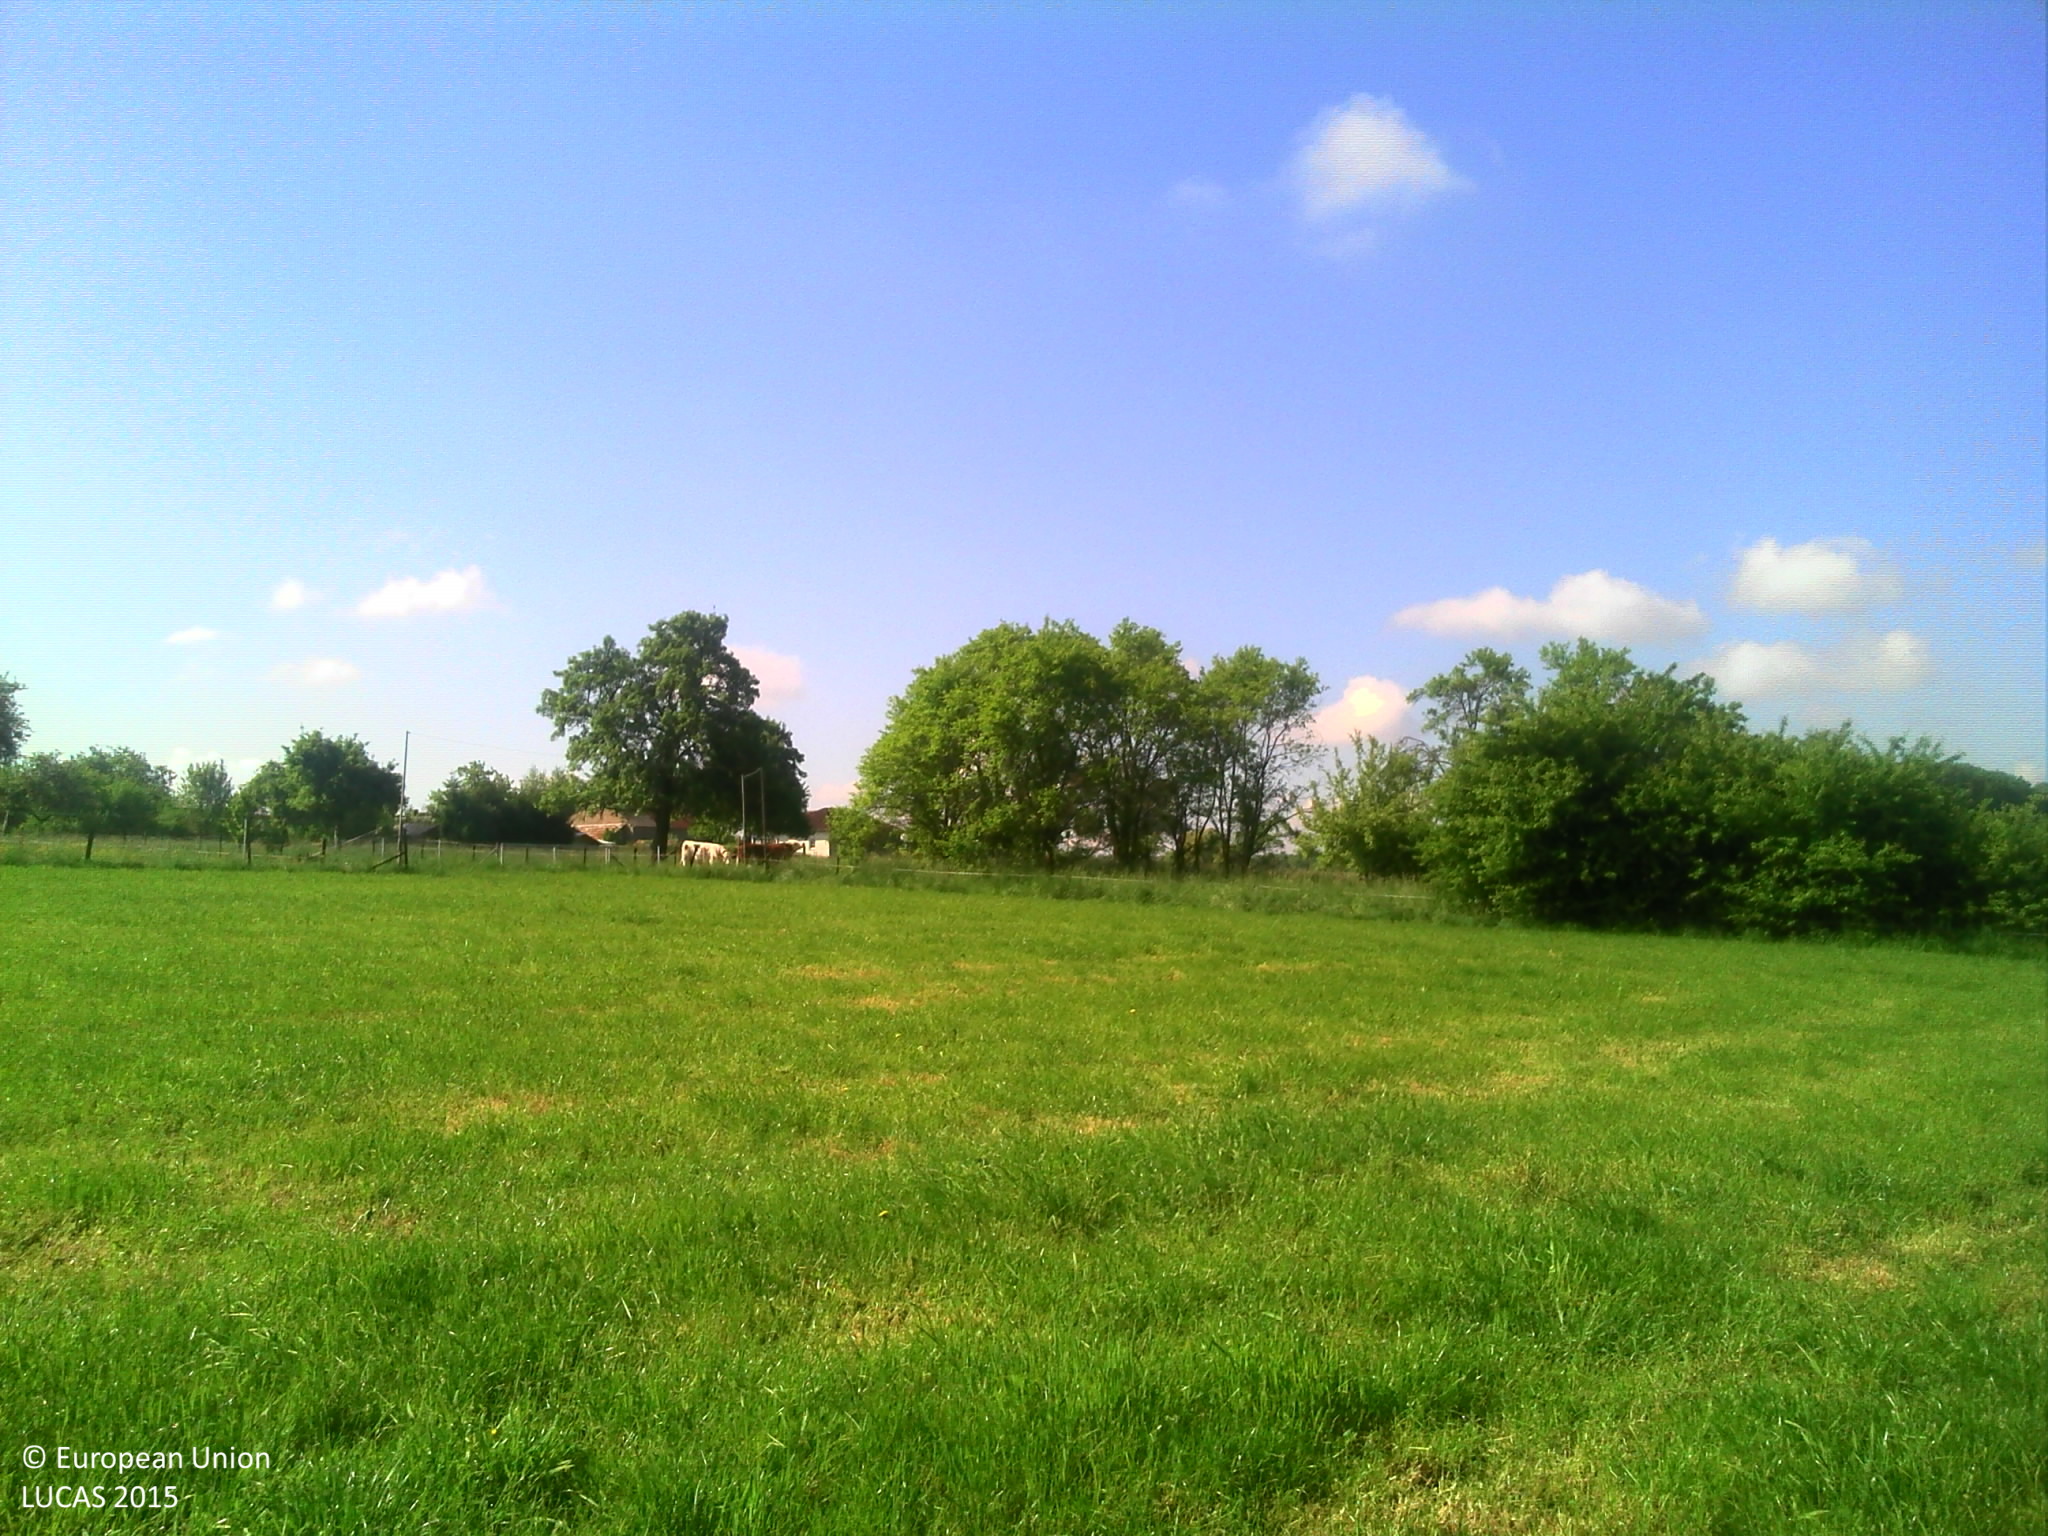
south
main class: Grassland
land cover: Grassland without tree/shrub cover
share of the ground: > 75 %
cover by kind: herbaceous plants 100 %
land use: Agriculture (excluding fallow land and kitchen gardens)
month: May
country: LU
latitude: 49.8196
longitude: 6.3441
